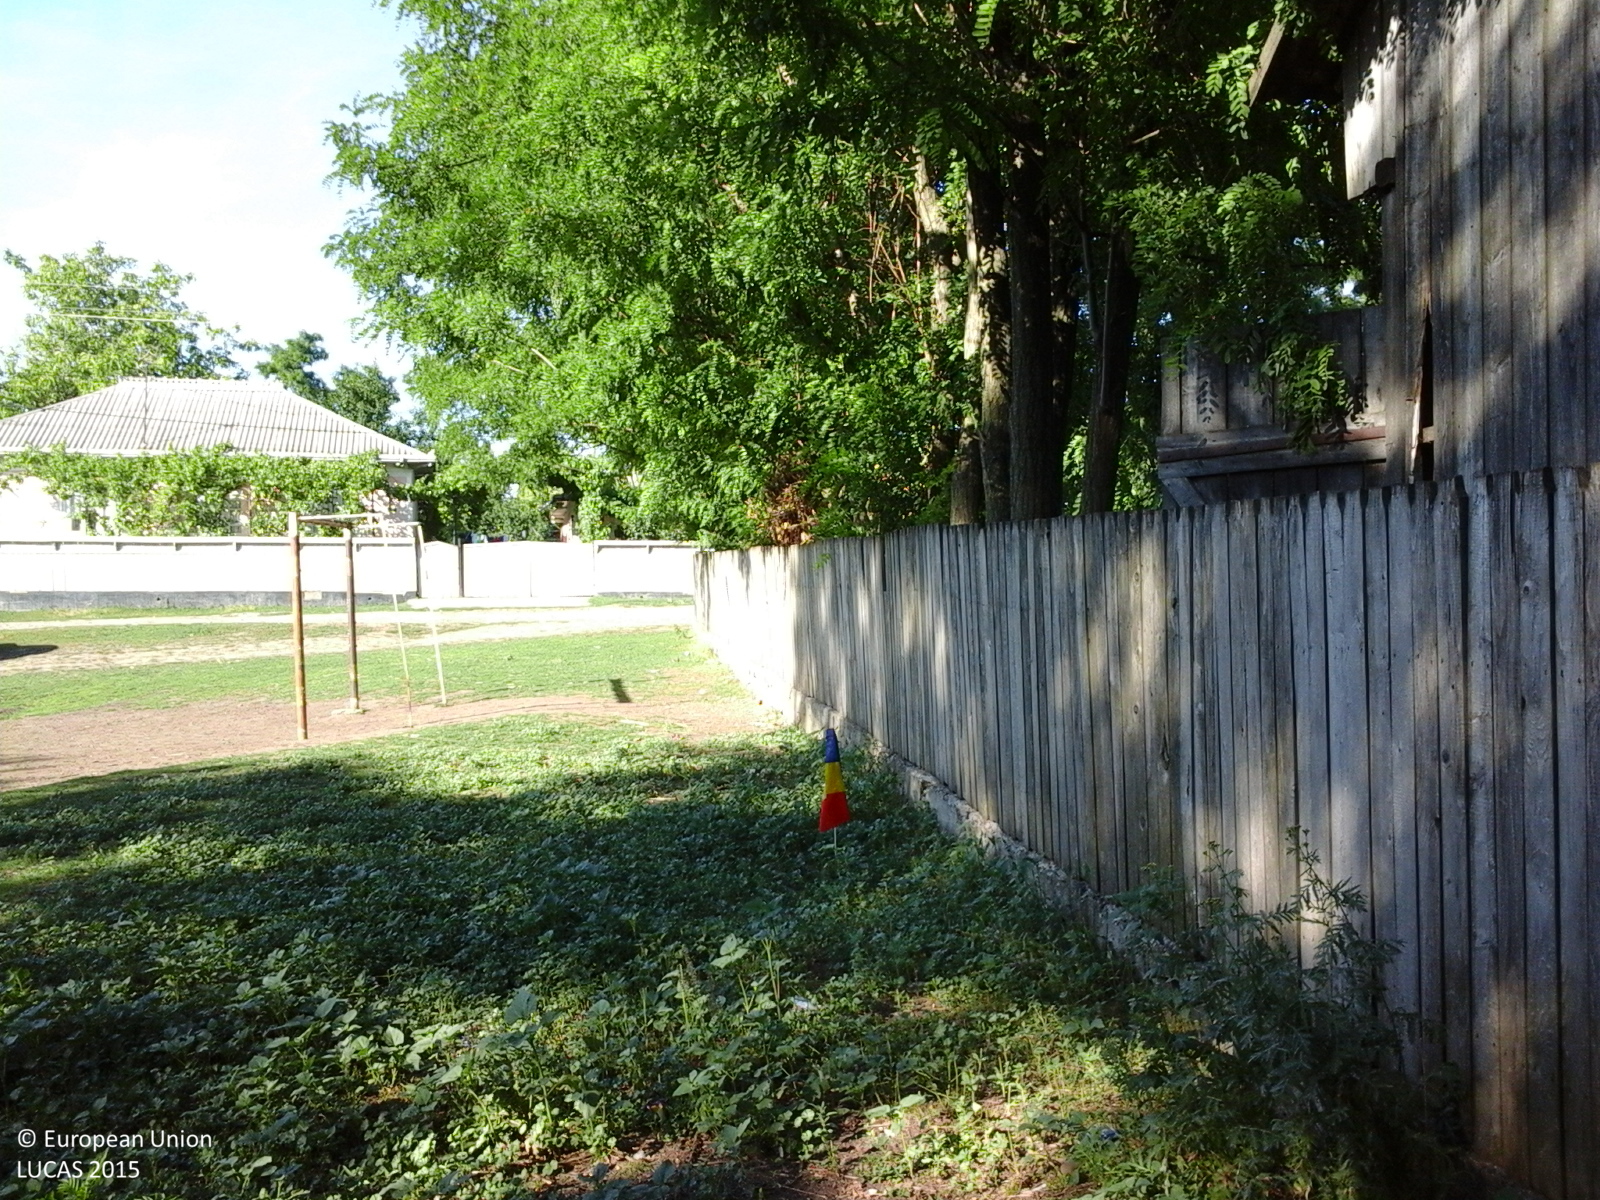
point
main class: Grassland
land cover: Grassland without tree/shrub cover
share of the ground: > 75 %
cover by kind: herbaceous plants 100 %
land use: Sport
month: June
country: RO
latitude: 47.4627
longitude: 27.0994
